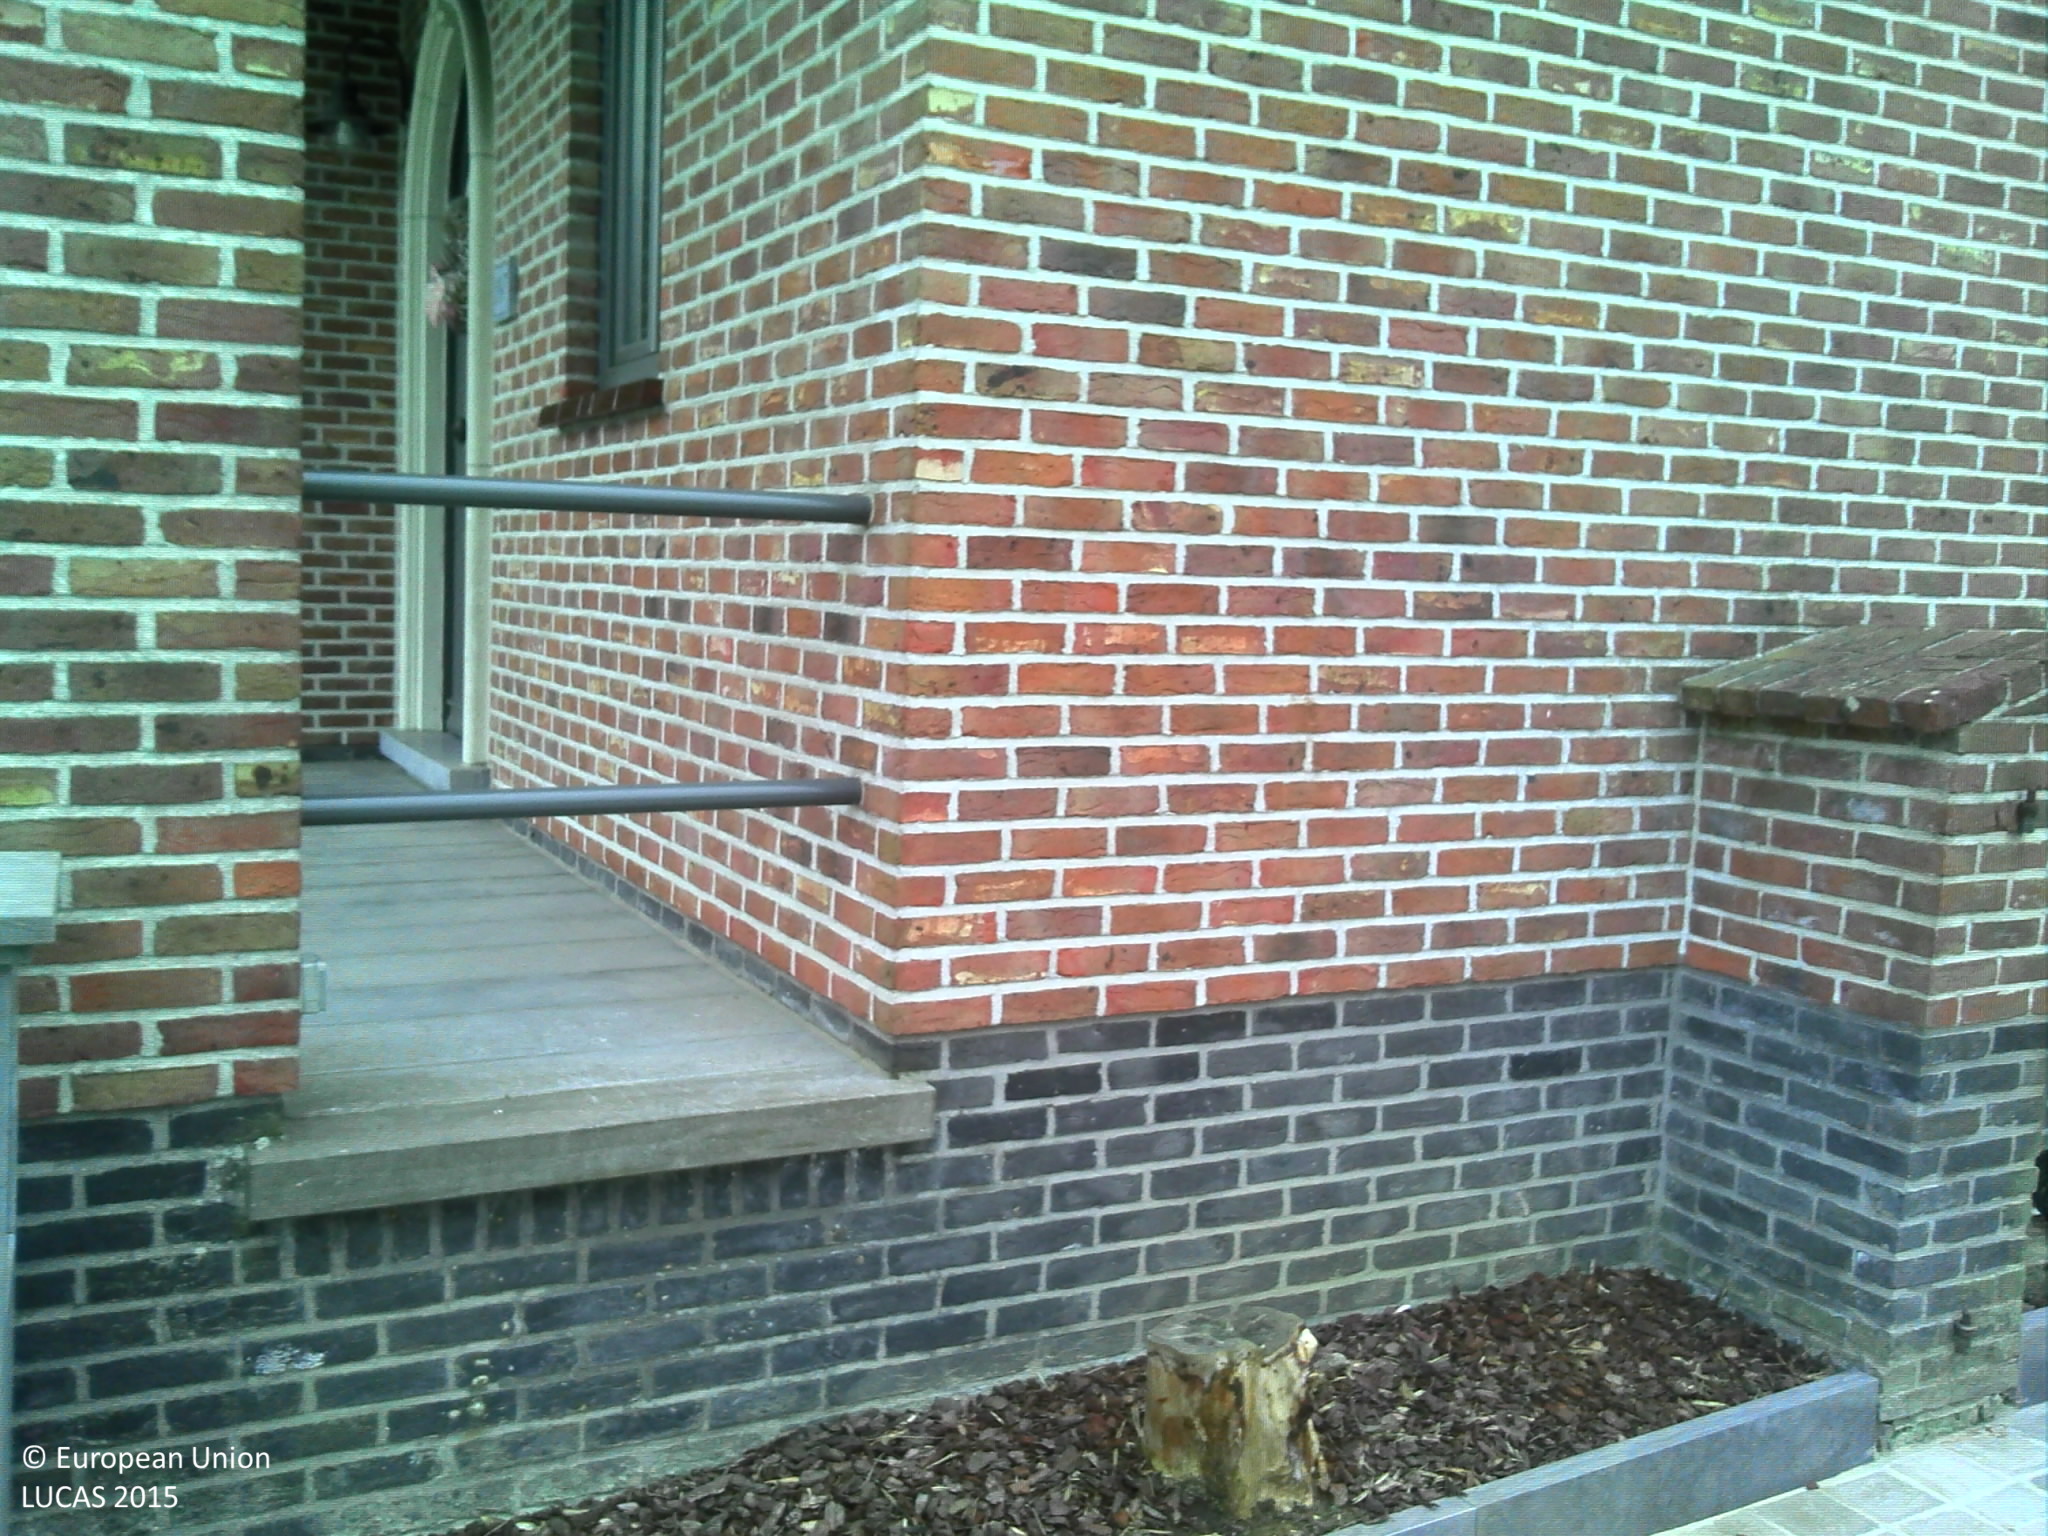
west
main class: Grassland
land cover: Grassland with sparse tree/shrub cover
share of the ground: > 75 %
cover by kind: herbaceous plants 95 %, broadleaved forest trees 5 %
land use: Residential
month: June
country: BE
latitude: 50.9042
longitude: 3.8932
